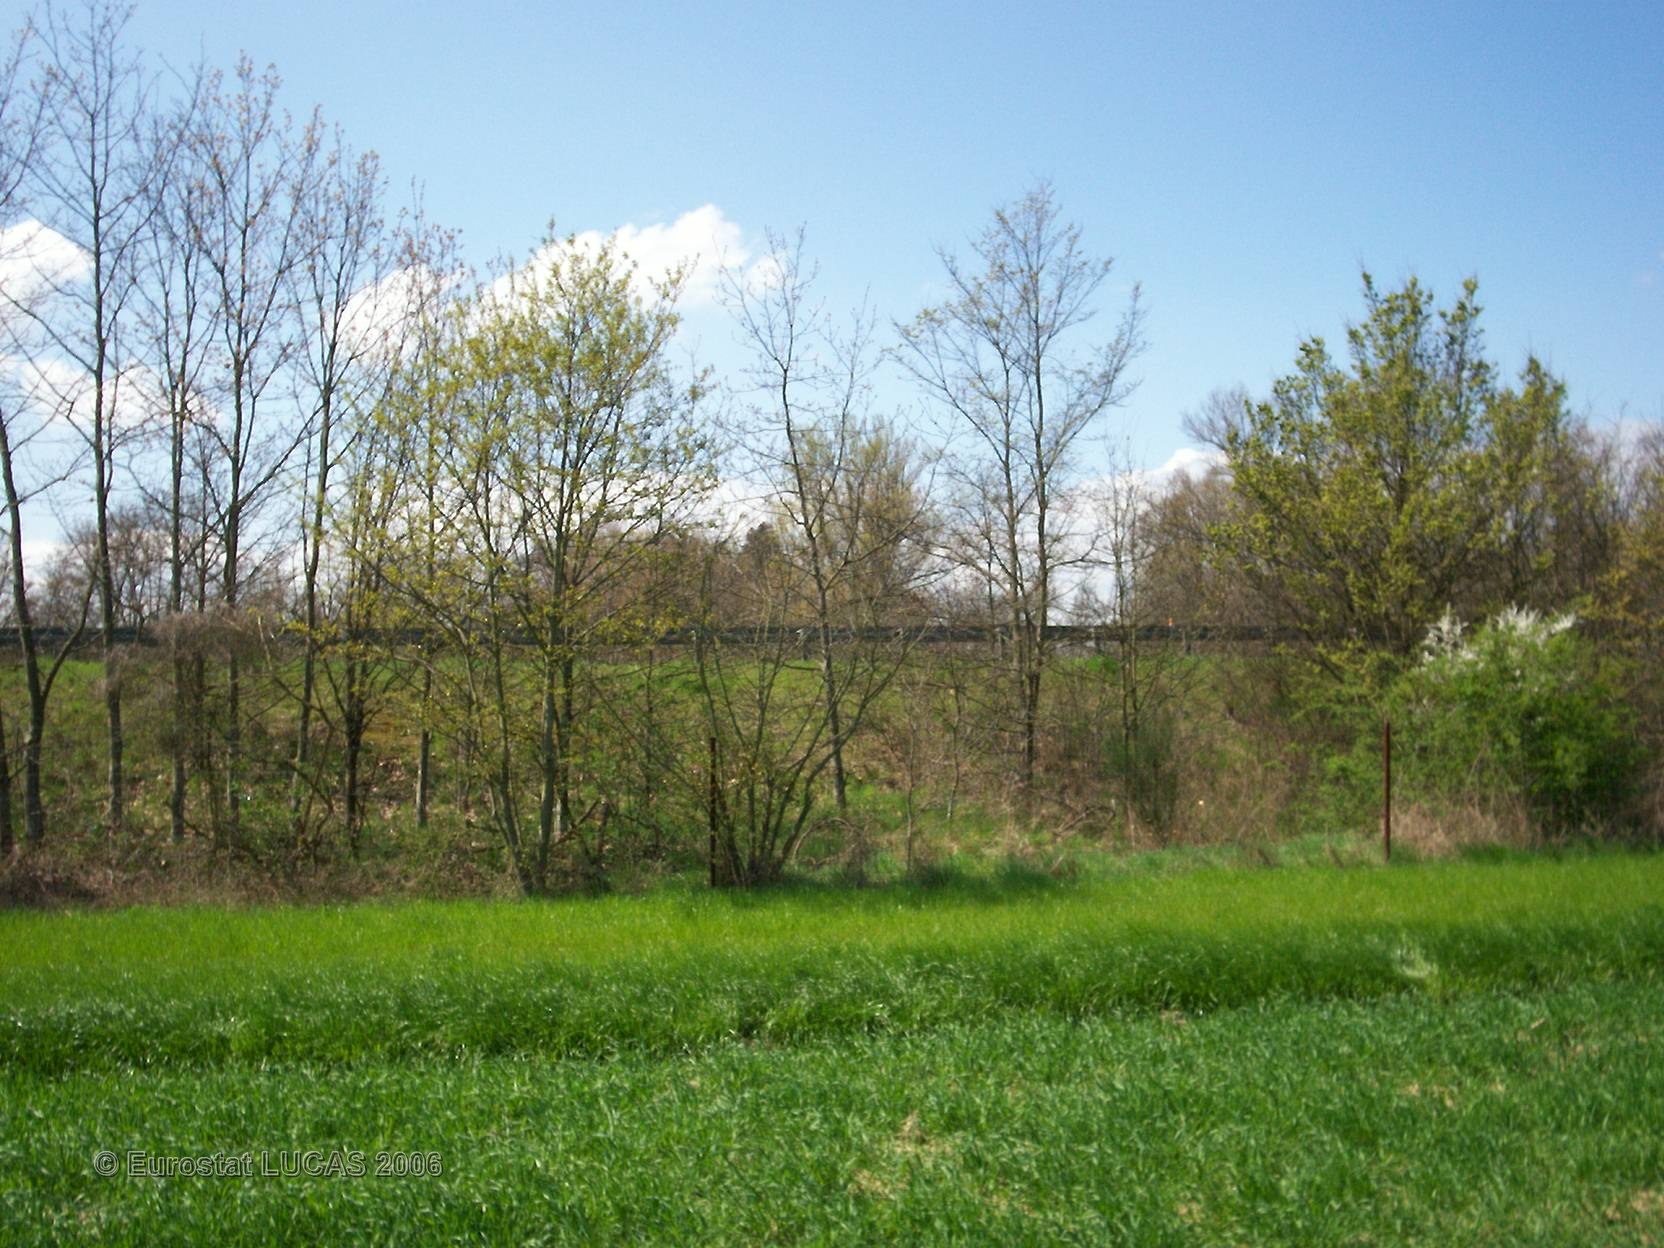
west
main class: Cropland
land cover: Common wheat
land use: Agriculture (excluding fallow land and kitchen gardens)
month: April
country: FR
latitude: 45.7413
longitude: 4.1804
